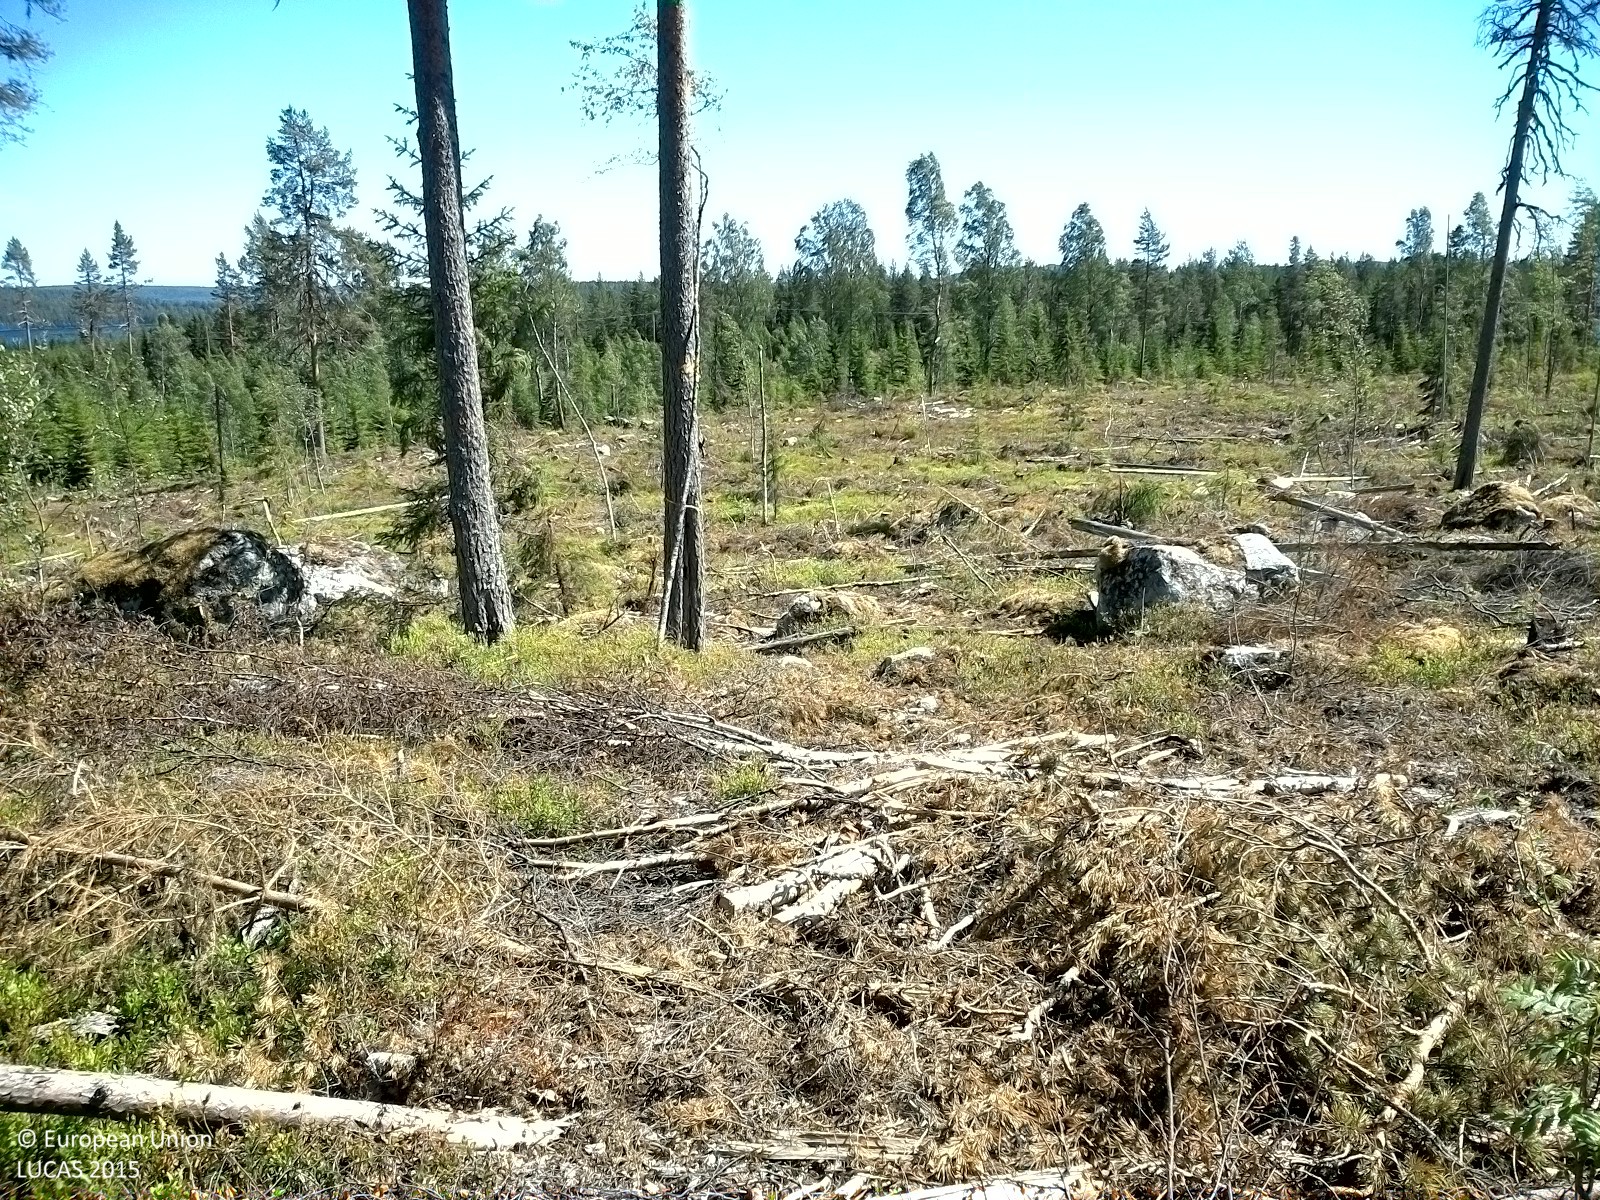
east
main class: Shrubland
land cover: Shrubland with sparse tree cover
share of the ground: 50 - 75 %
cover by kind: shrubs 55 %, unconsolidated bare surface 15 %, broadleaved forest trees 5 %
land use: Forestry
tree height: < 5 m
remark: Clear cut
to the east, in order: Shrubland with sparse tree cover; Tracks; Shrubland with sparse tree cover; Broadleaved woodland; Shrubland with sparse tree cover; Tracks; Shrubland with sparse tree cover; Tracks; Shrubland with sparse tree cover; Electric lines; Spruce dominated coniferous woodland
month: July
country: SE
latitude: 62.2338
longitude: 16.9655
